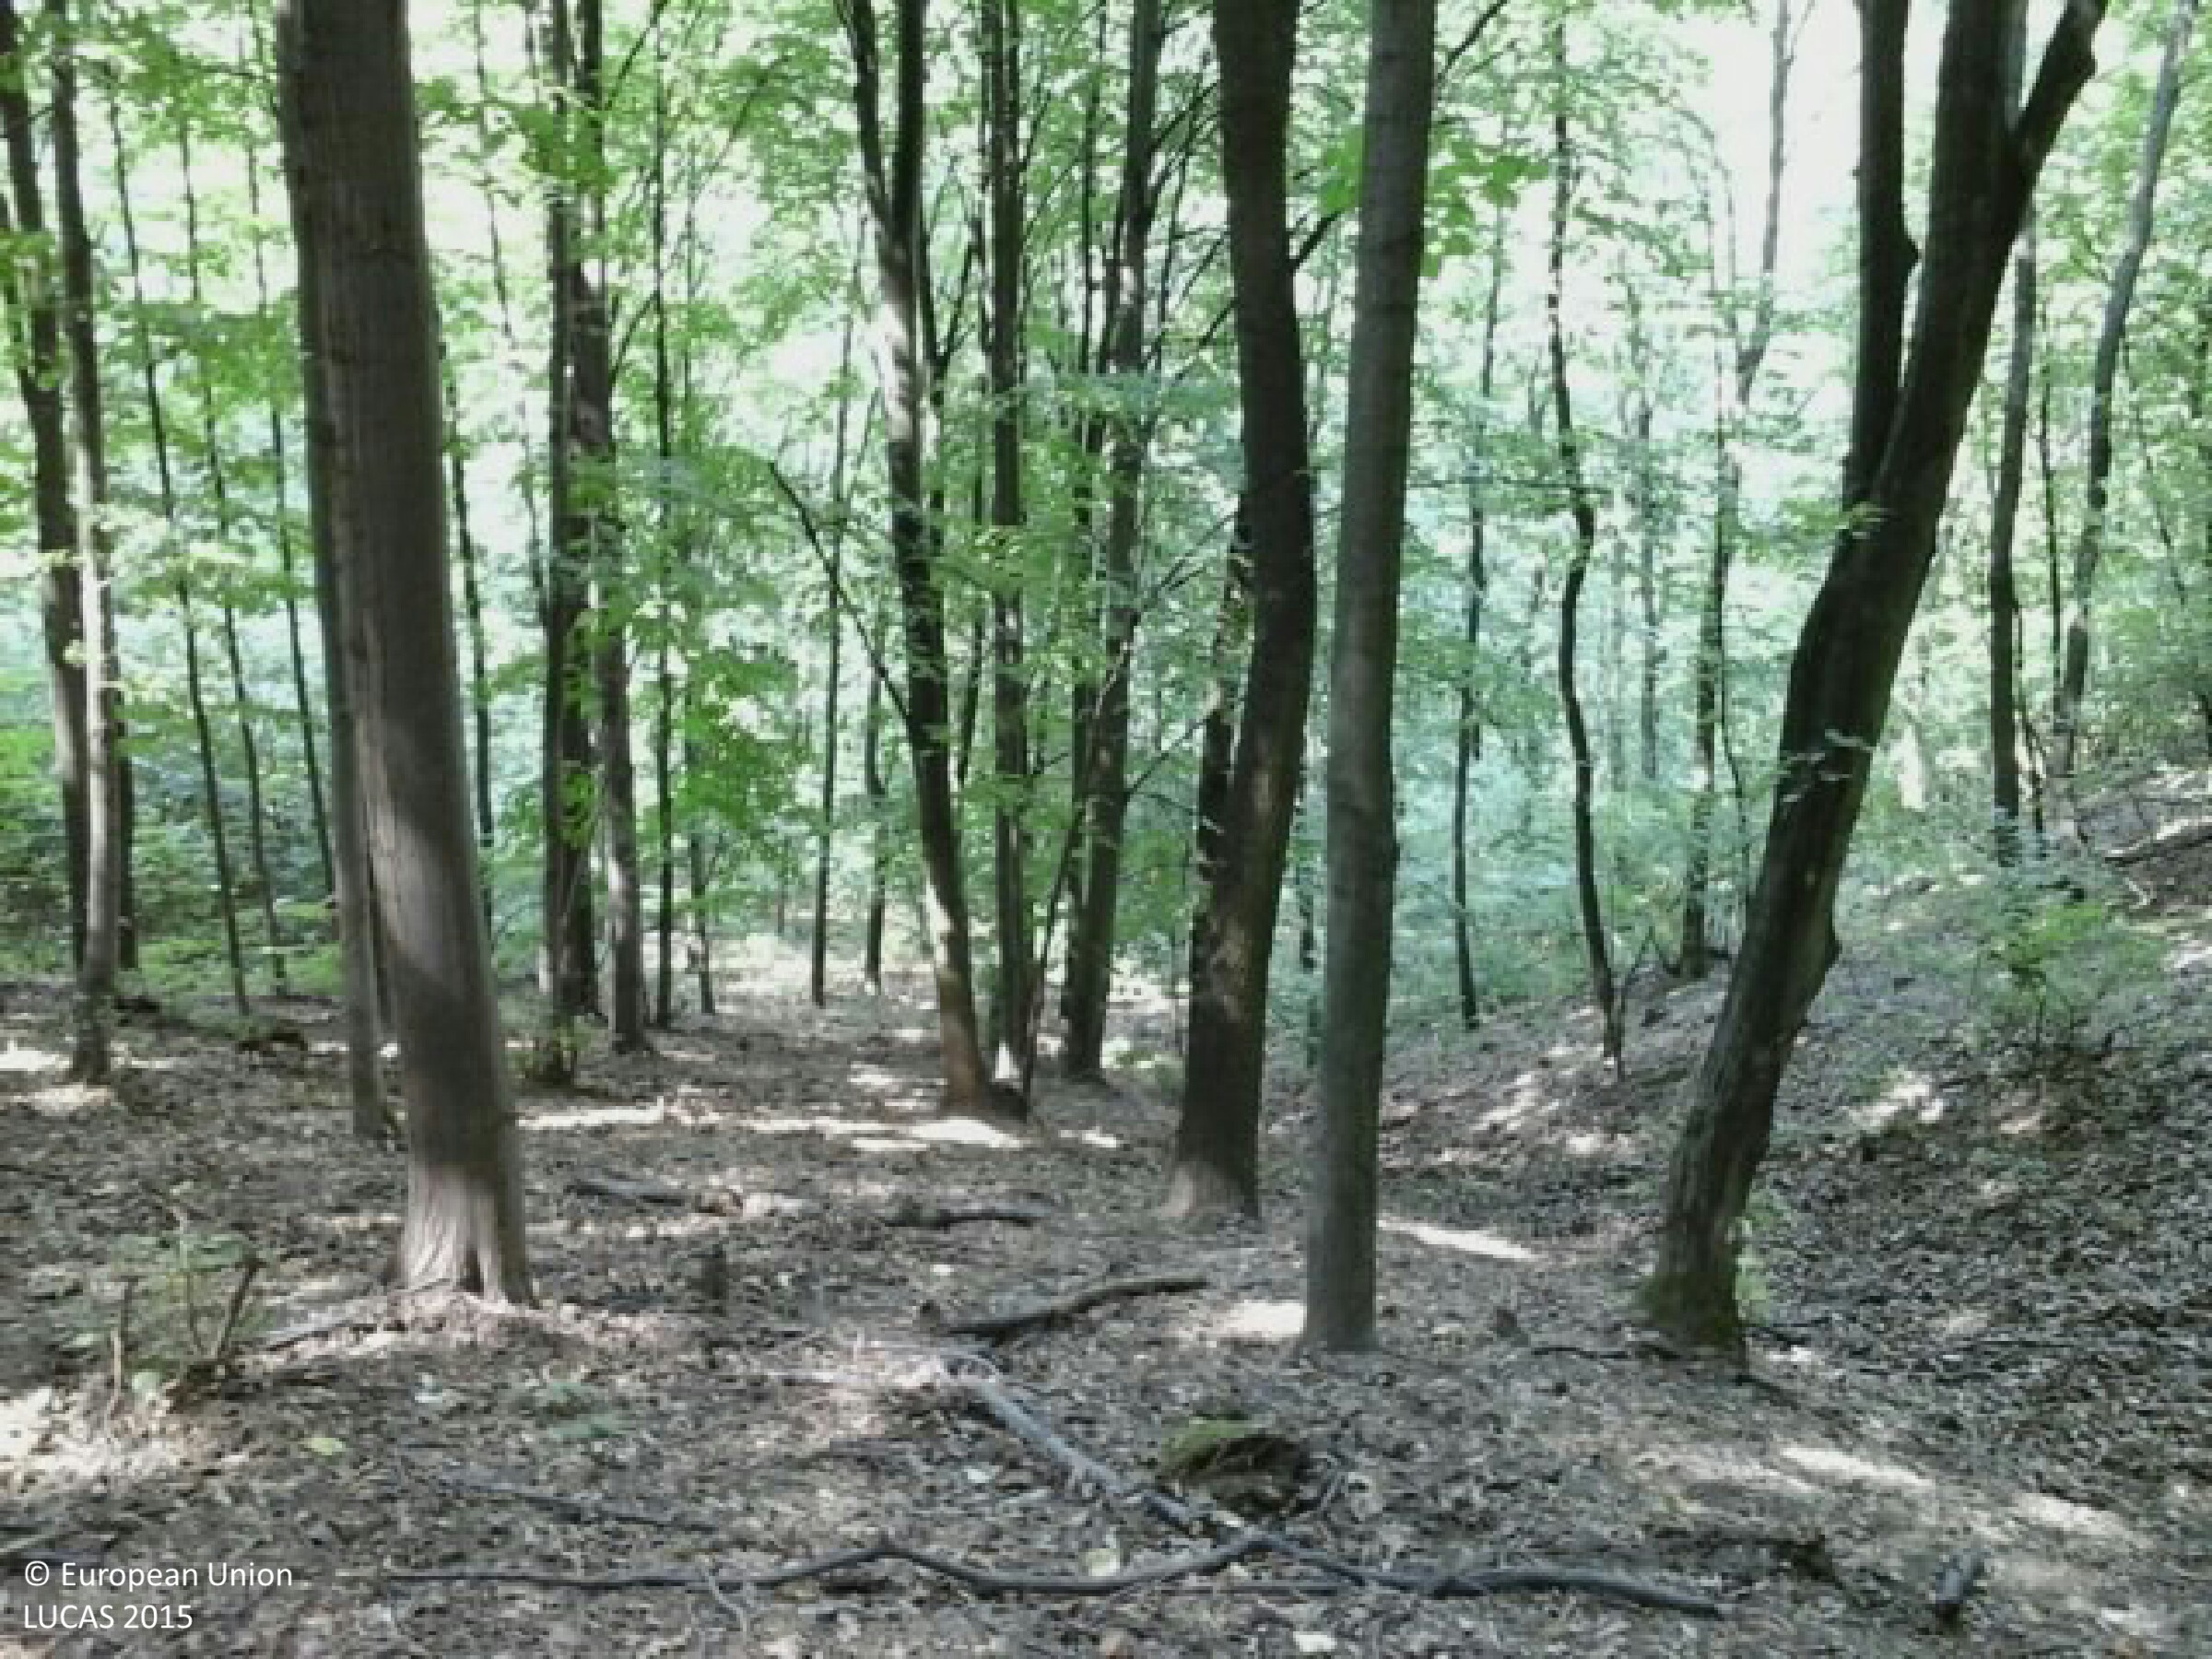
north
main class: Woodland
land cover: Broadleaved woodland
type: beech forest
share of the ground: 50 - 75 %
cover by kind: broadleaved forest trees 100 %
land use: Forestry
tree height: > 5 m
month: July
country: HU
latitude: 47.7958
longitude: 19.2723
